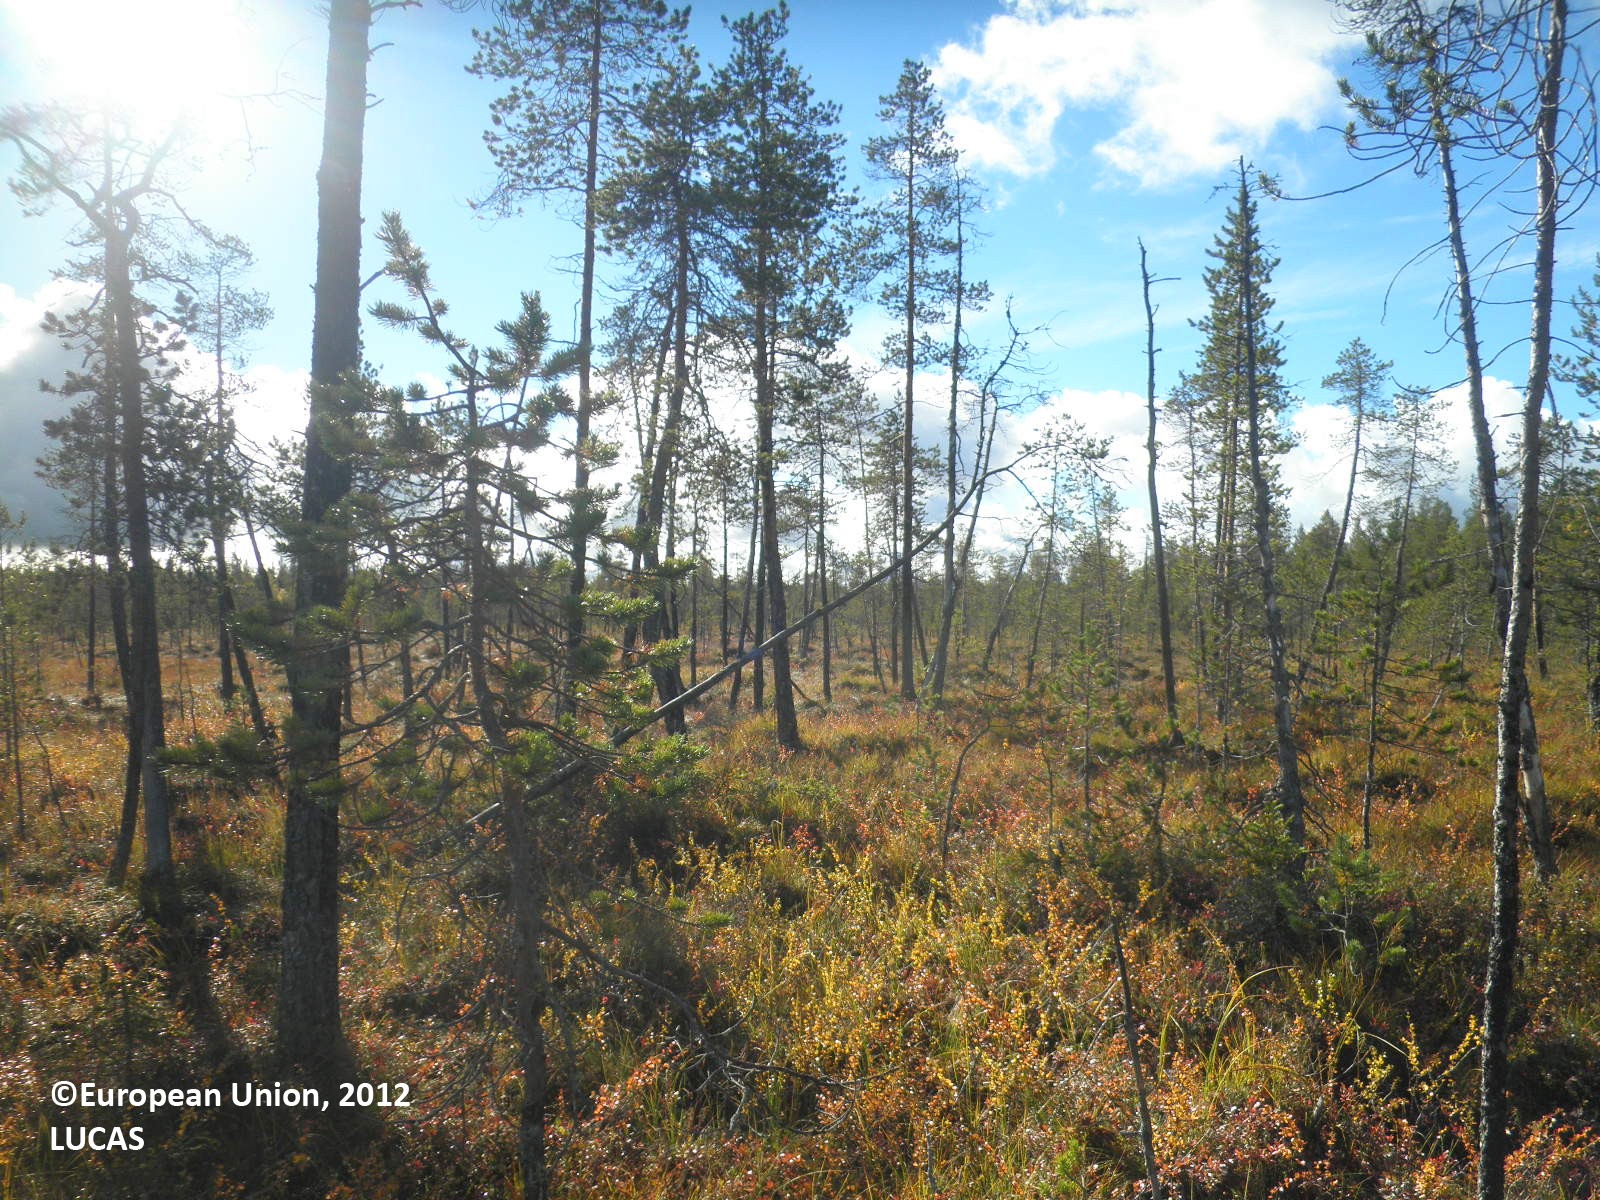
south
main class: Woodland
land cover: Pine dominated coniferous woodland
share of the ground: 10 - 25 %
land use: Forestry
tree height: > 5 m
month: September
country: FI
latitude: 67.4527
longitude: 28.4738
